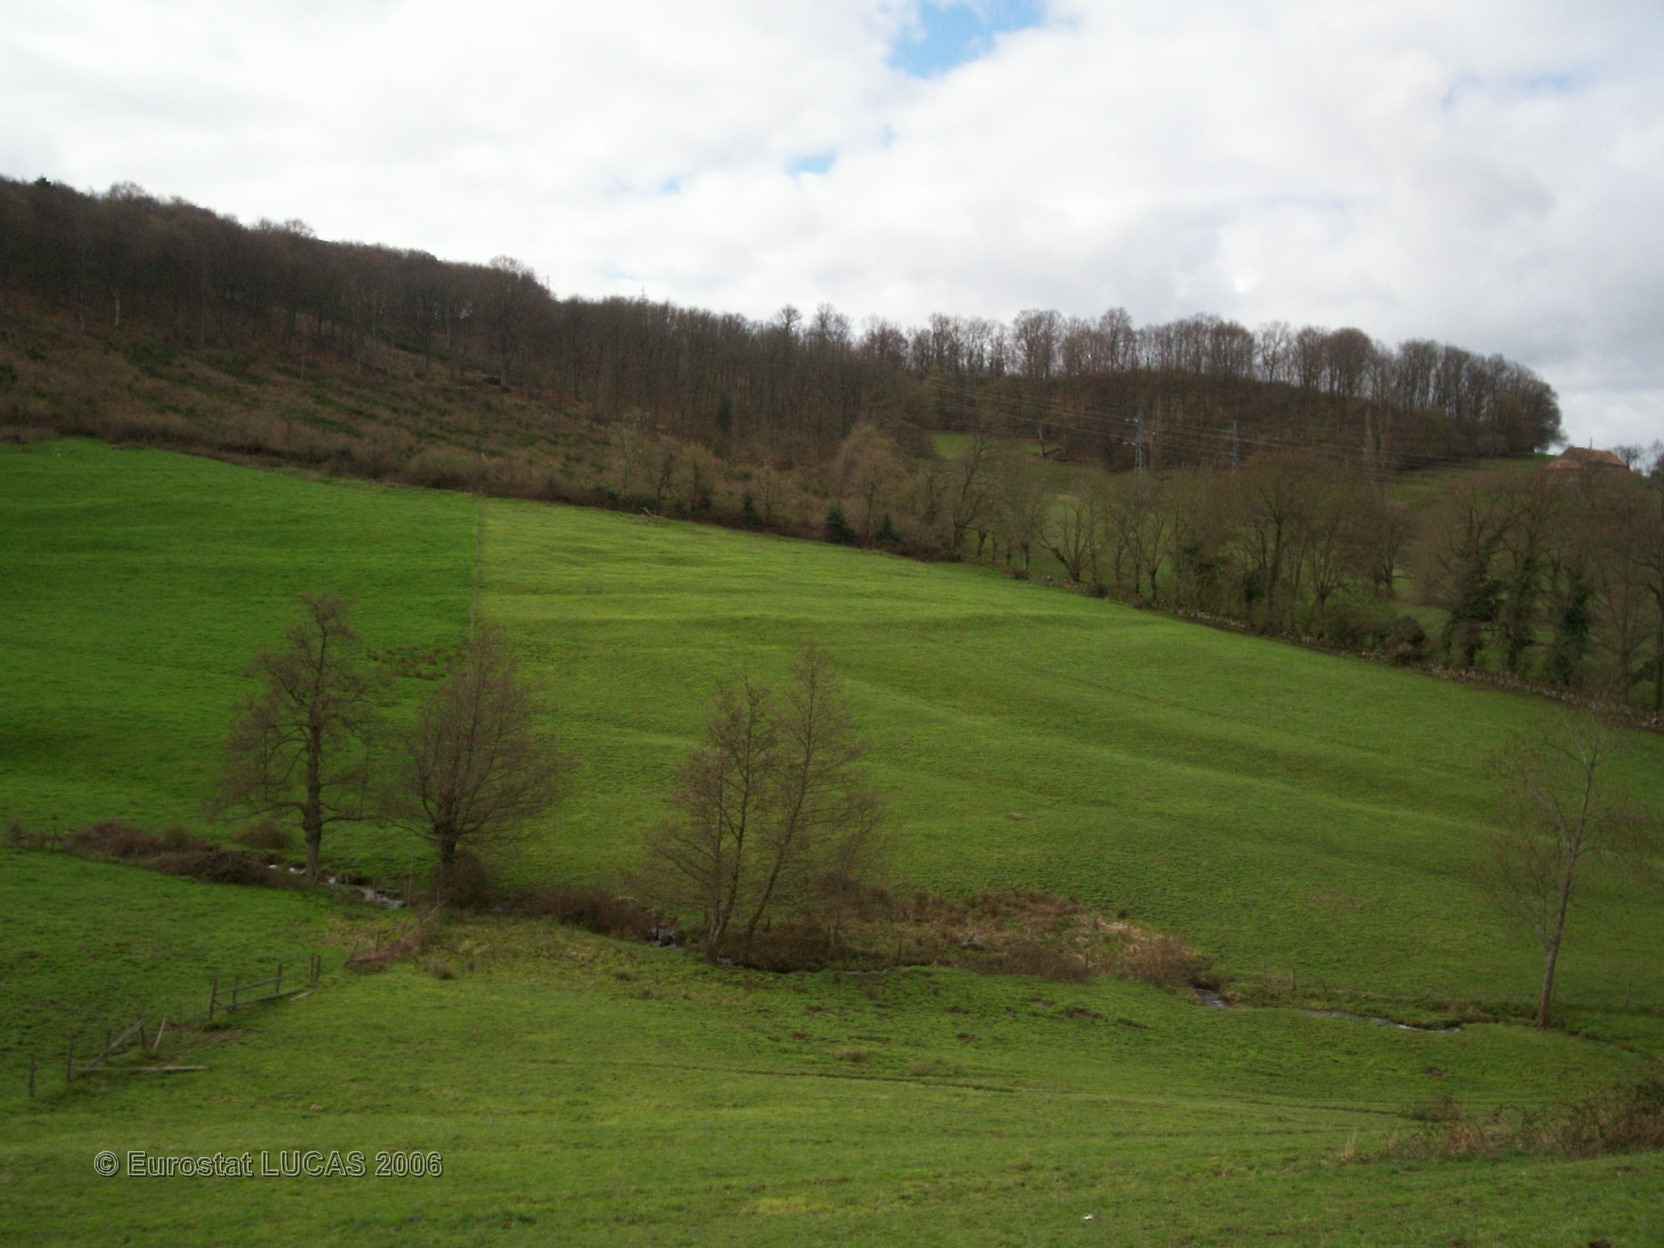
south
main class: Grassland
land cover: Grassland without tree/shrub cover
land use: Agriculture (excluding fallow land and kitchen gardens)
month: April
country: FR
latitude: 46.4174
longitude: 4.6805
